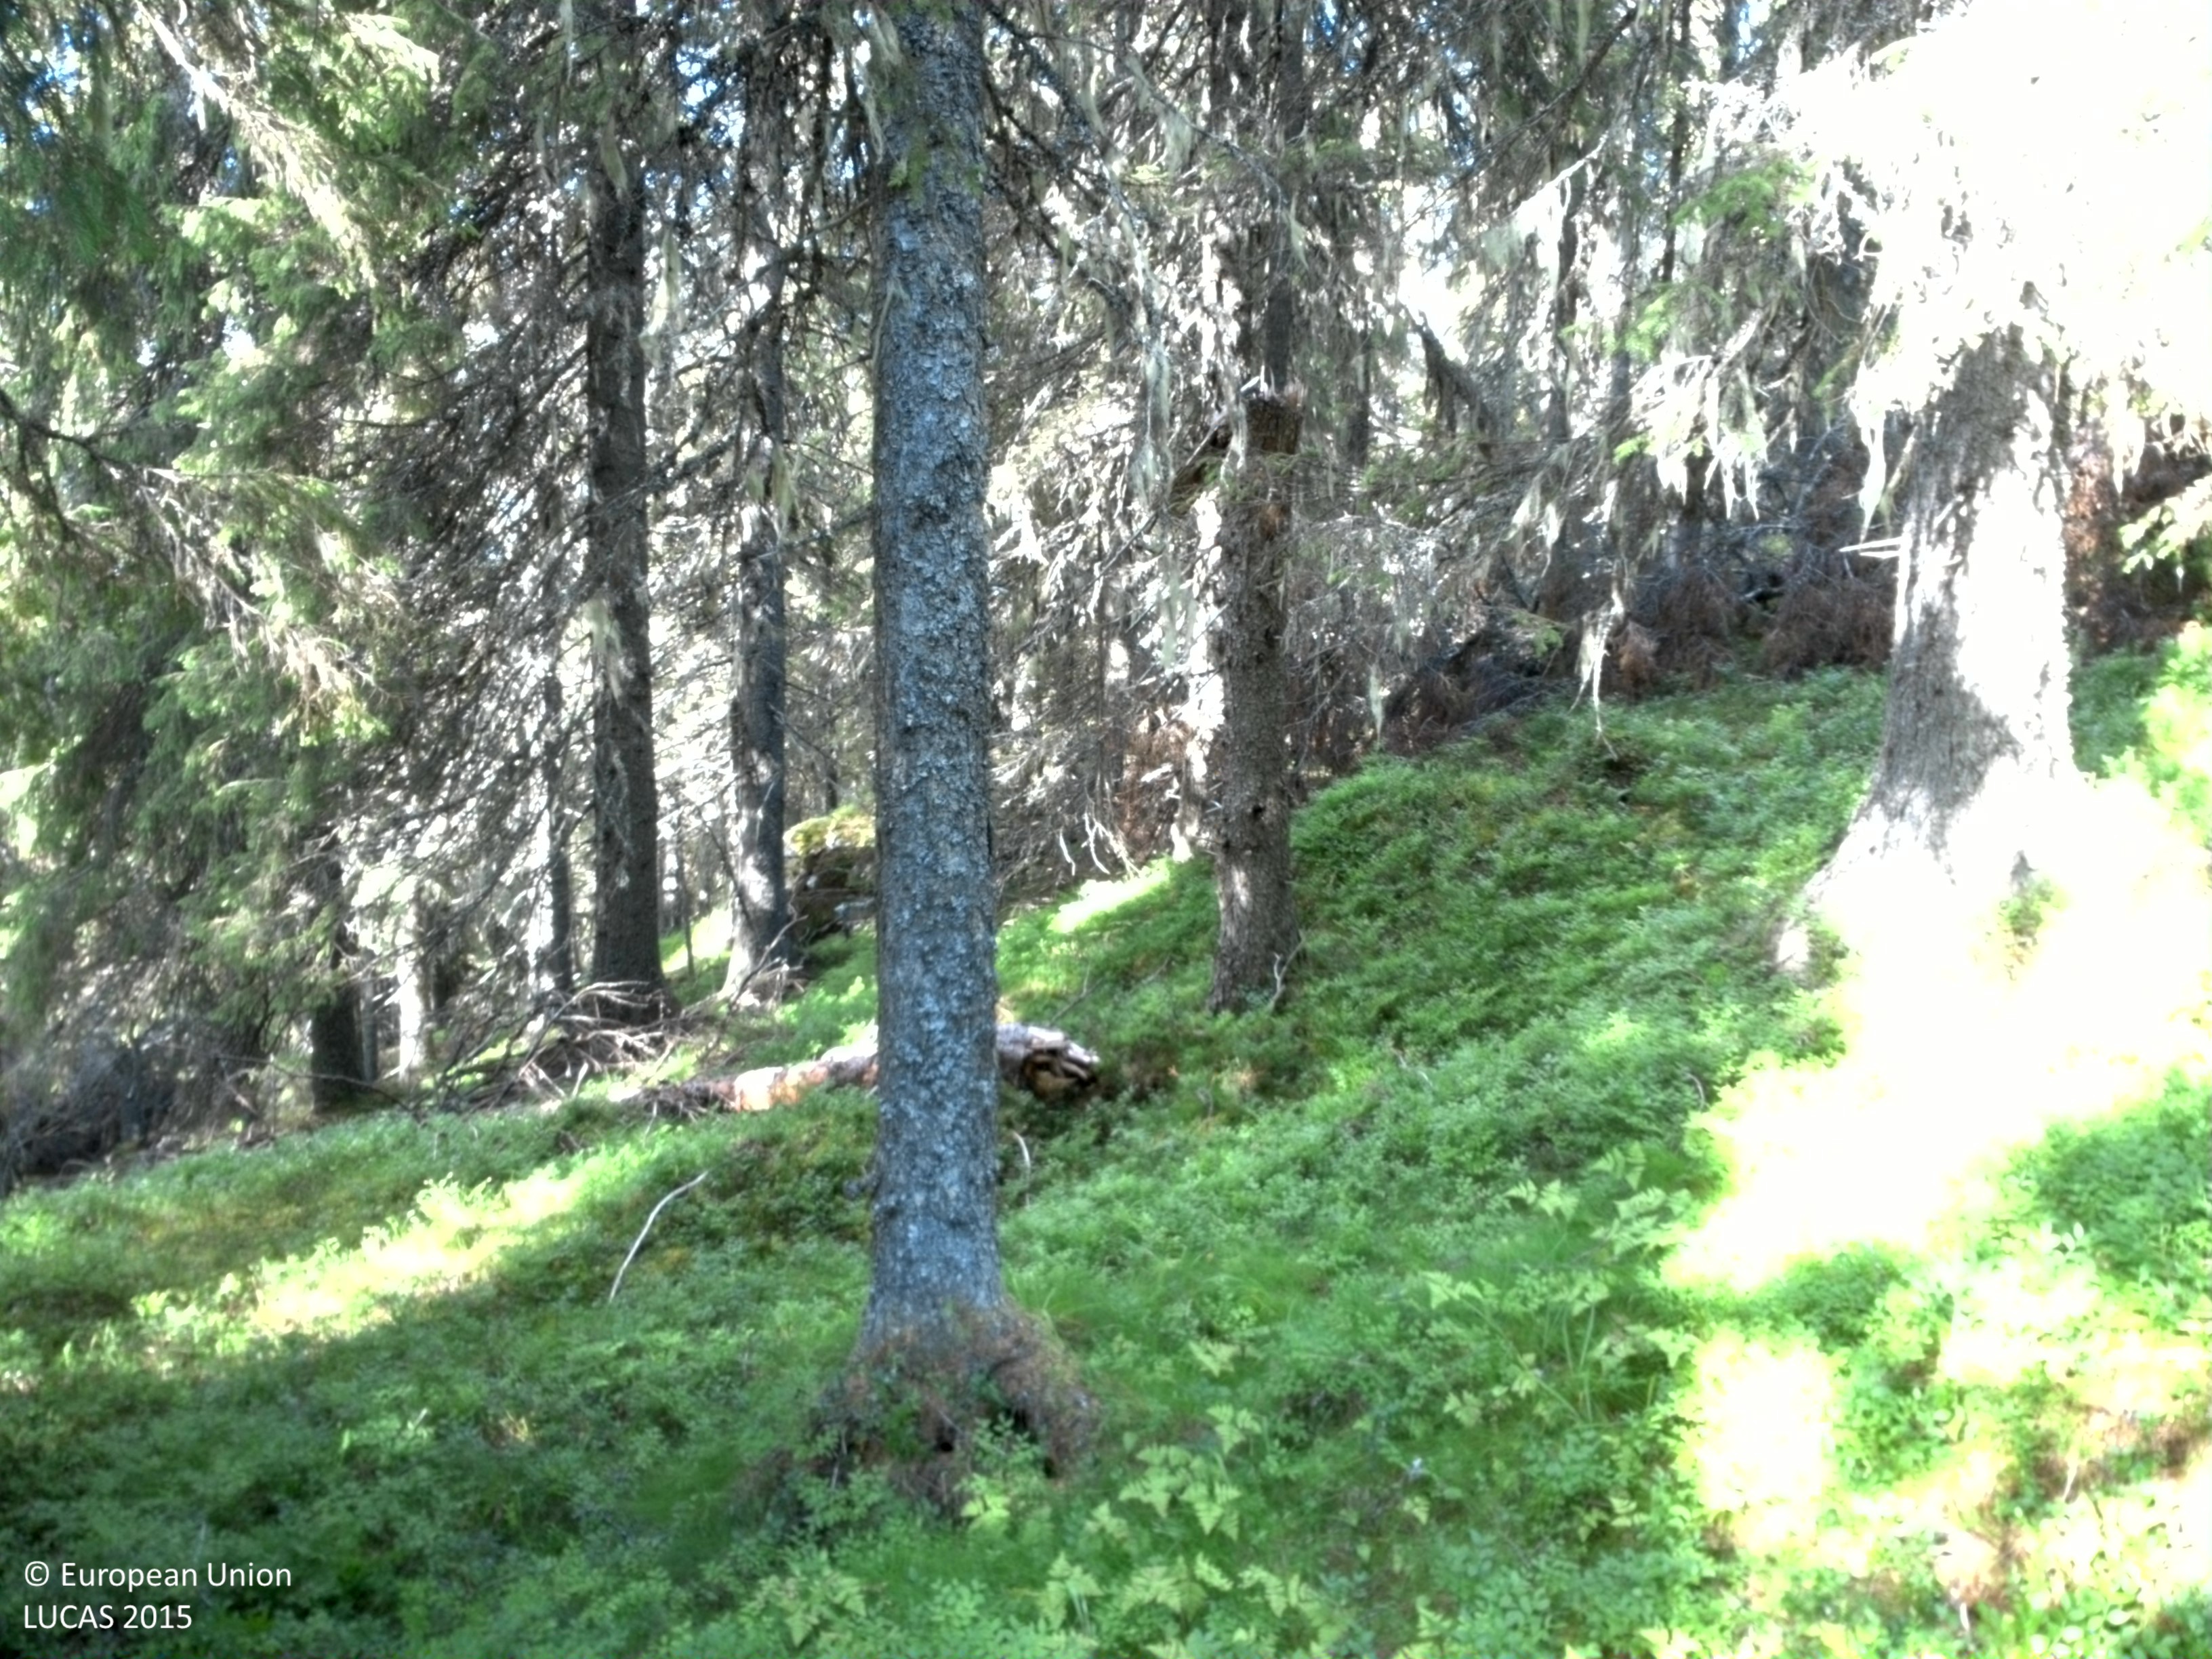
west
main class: Woodland
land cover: Spruce dominated coniferous woodland
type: boreal forest
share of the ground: 50 - 75 %
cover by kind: coniferous forest trees 60 %, shrubs 20 %, lichens and mosses 15 %, herbaceous plants 5 %
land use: Forestry
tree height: > 5 m
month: September
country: SE
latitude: 65.0255
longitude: 16.5236
